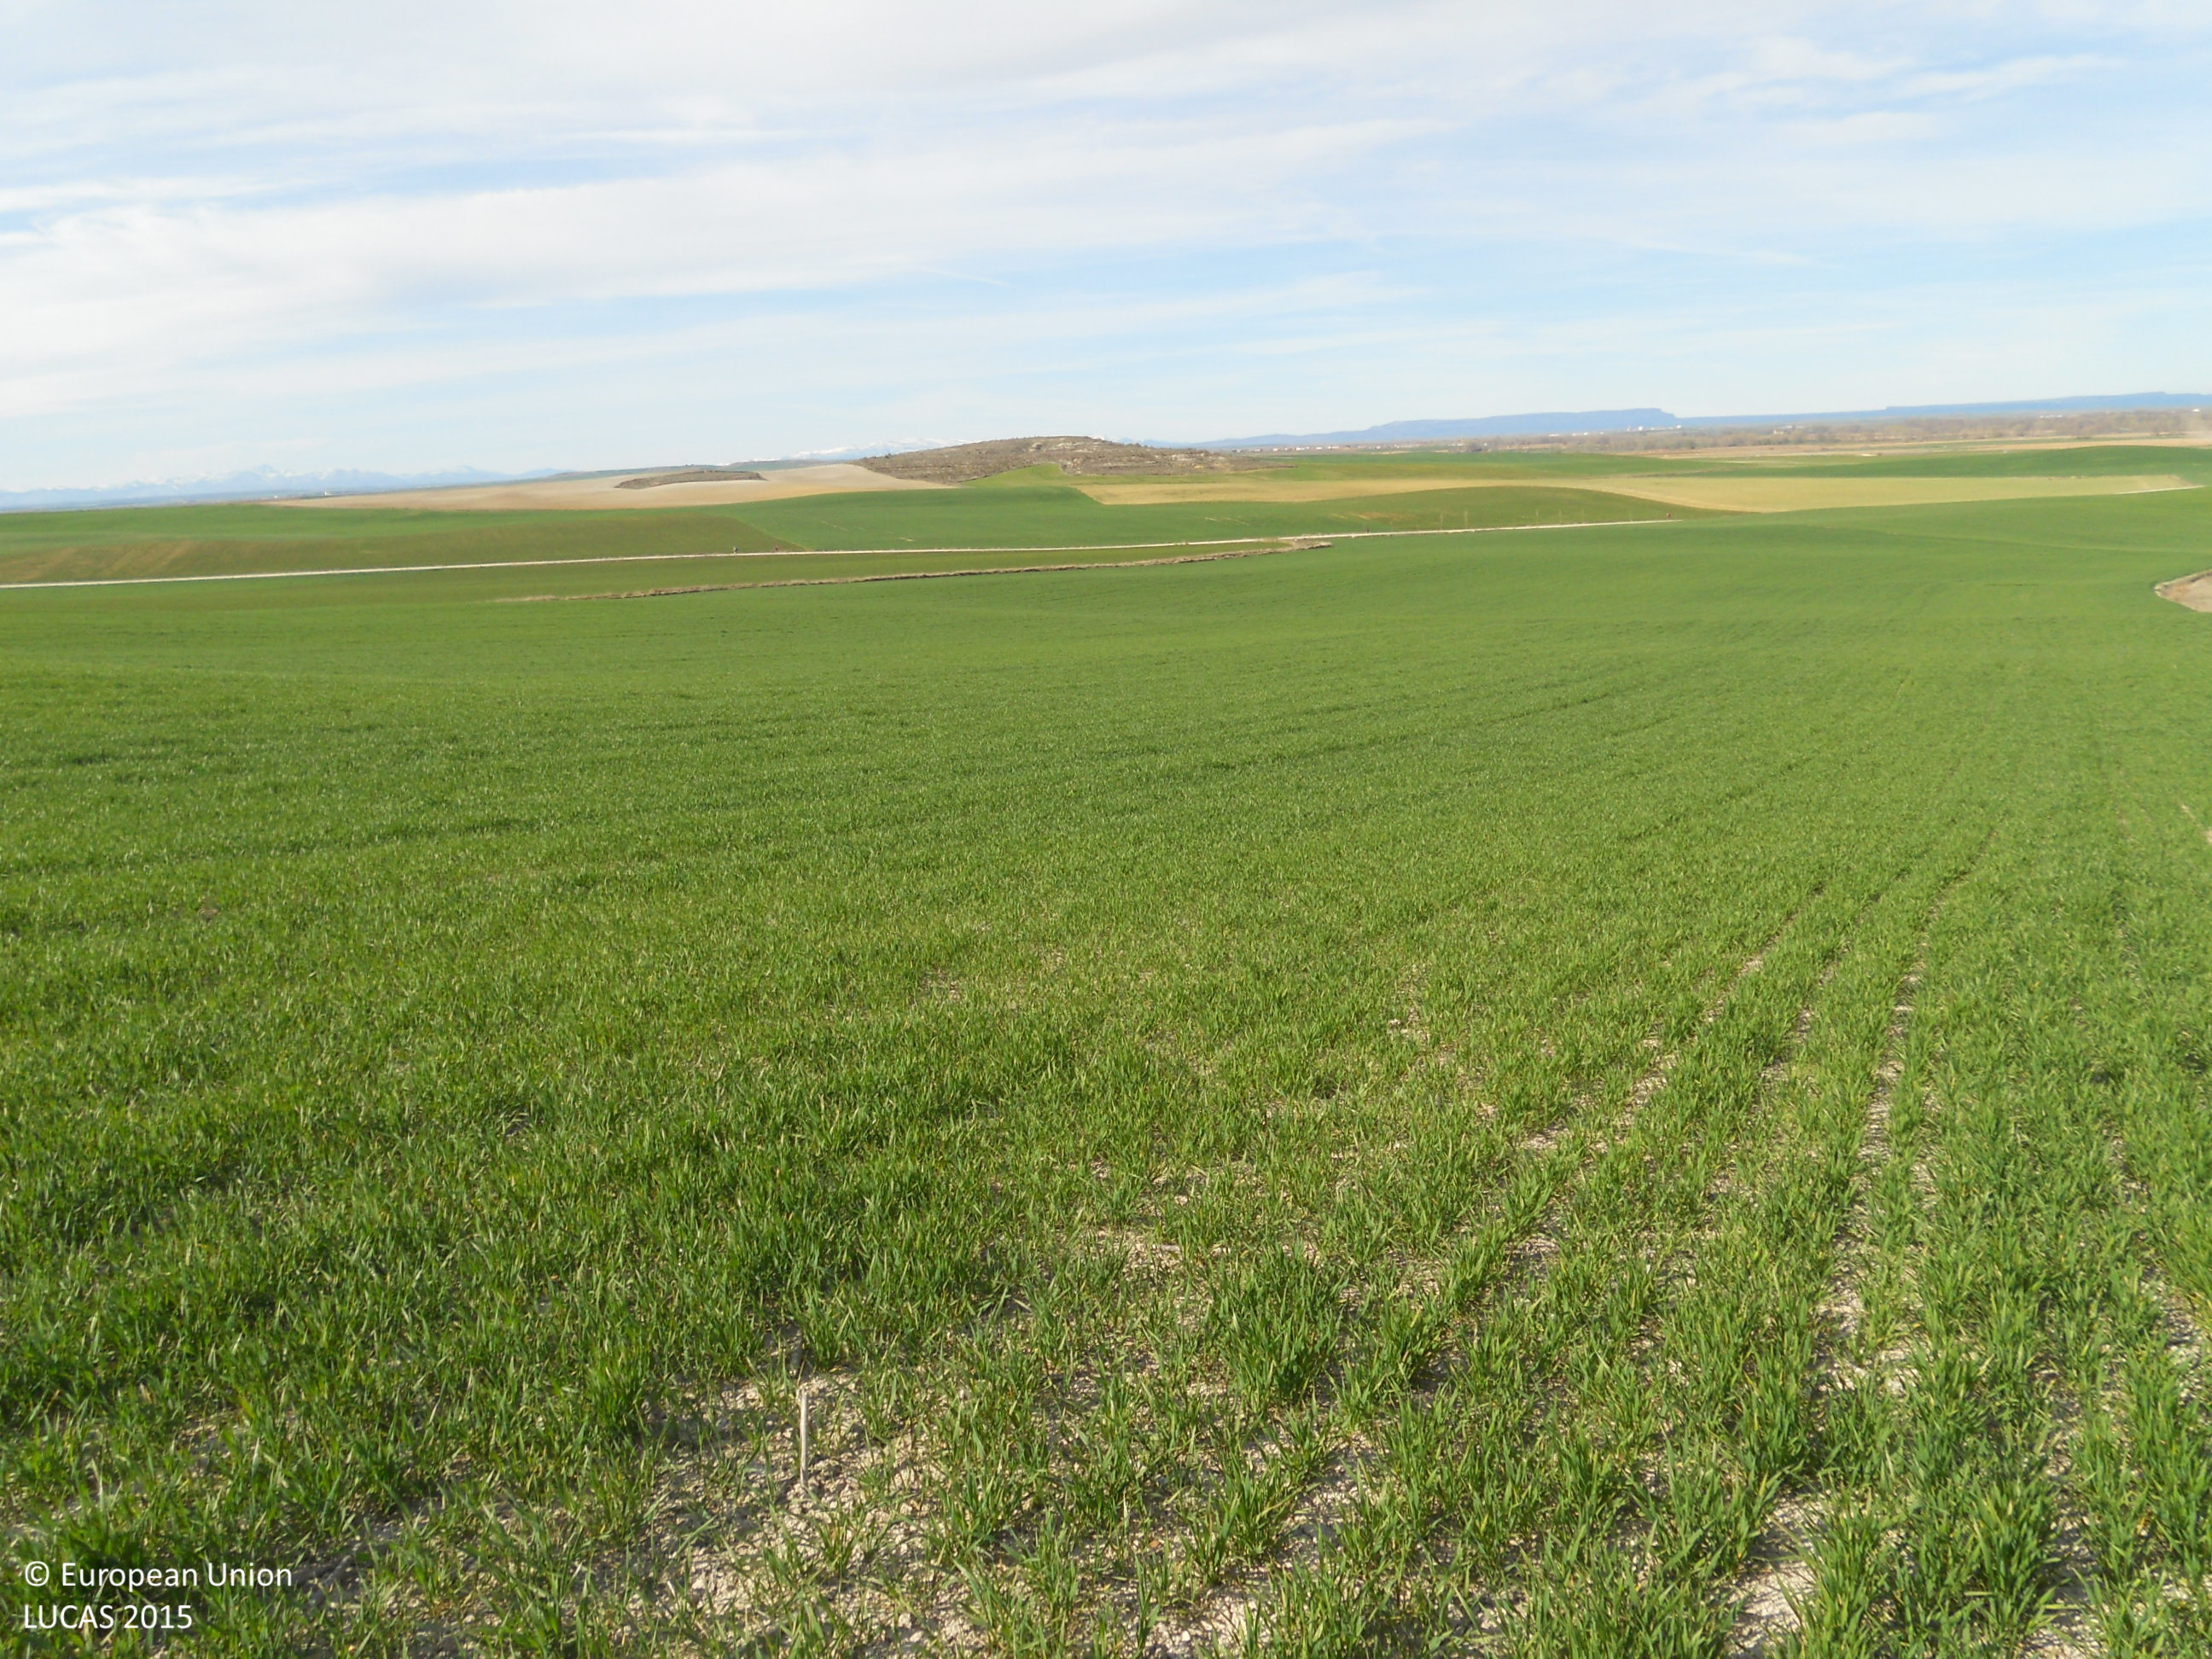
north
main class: Cropland
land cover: Barley
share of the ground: > 75 %
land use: Agriculture (excluding fallow land and kitchen gardens)
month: April
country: ES
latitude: 42.2754
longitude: -4.2921
